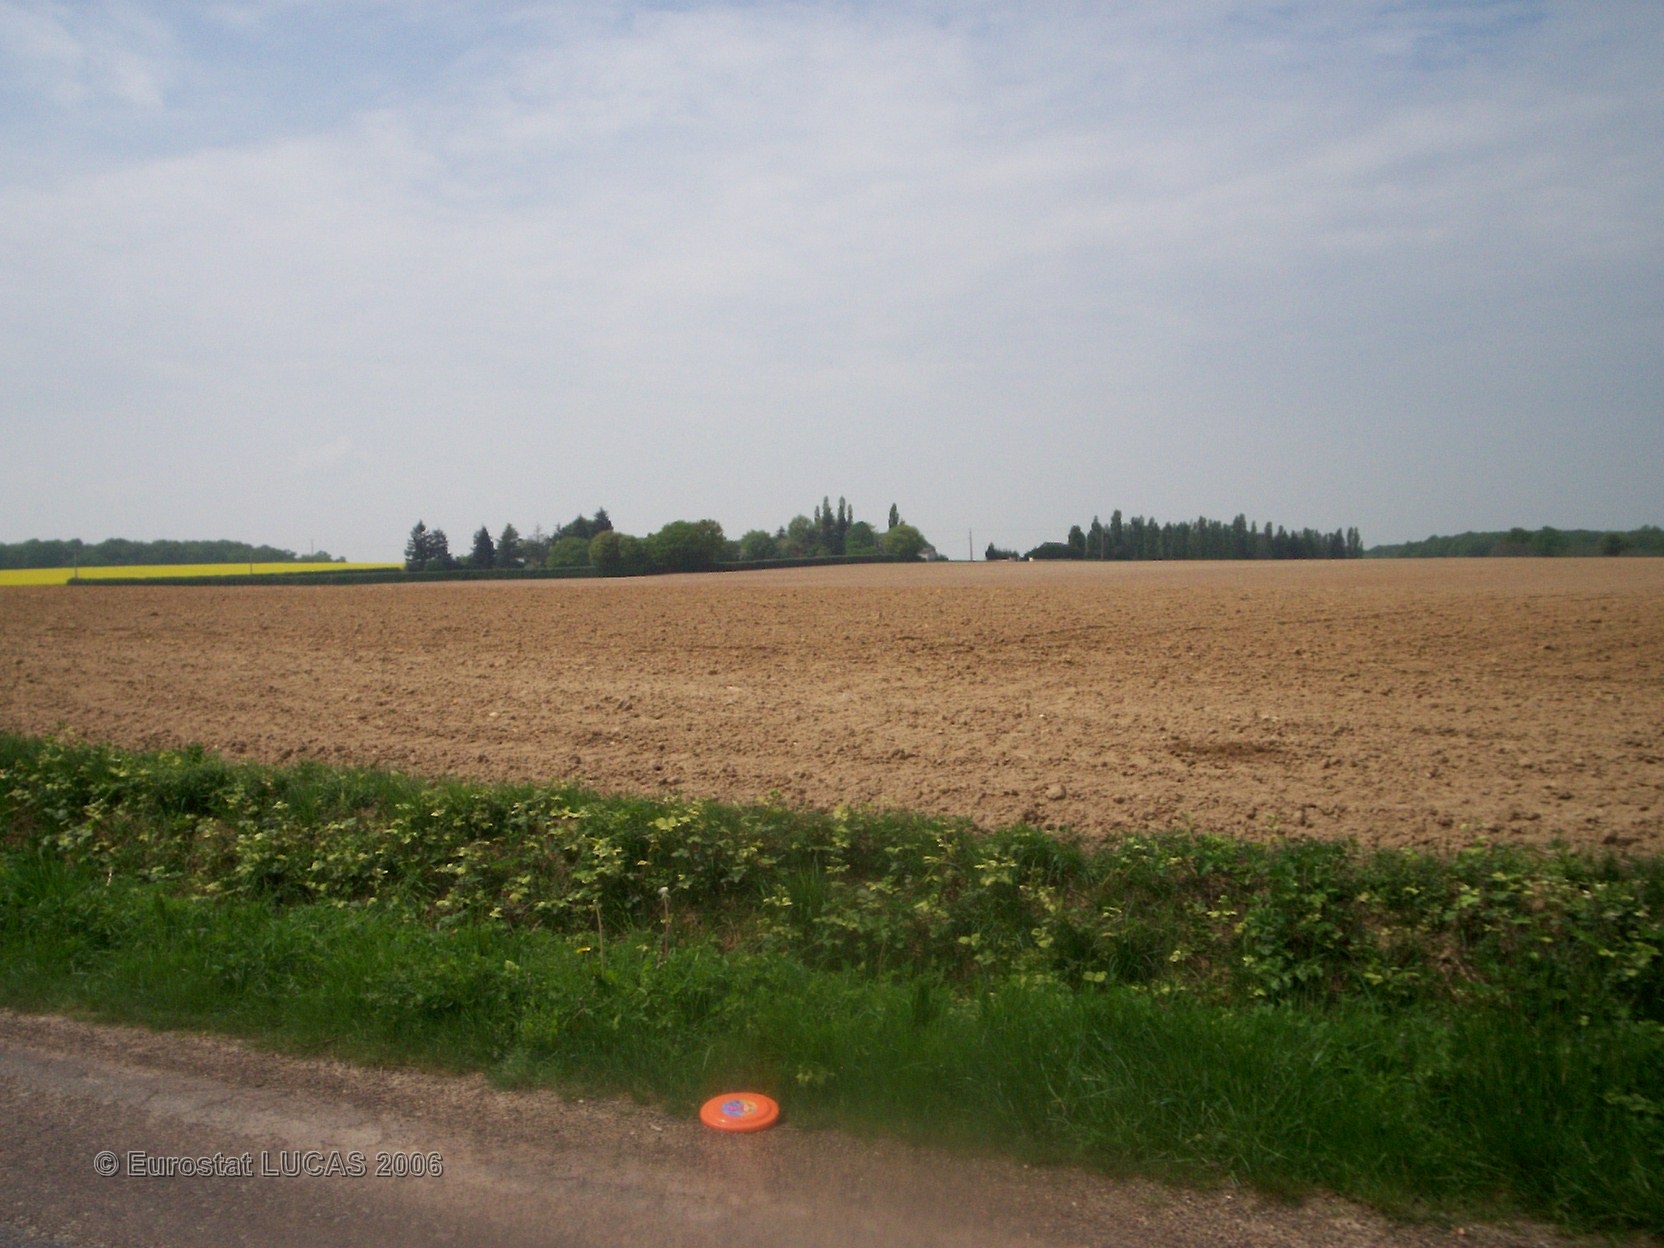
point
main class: Cropland
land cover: Sunflower
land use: Agriculture (excluding fallow land and kitchen gardens)
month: May
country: FR
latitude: 47.8890
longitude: 2.9449
